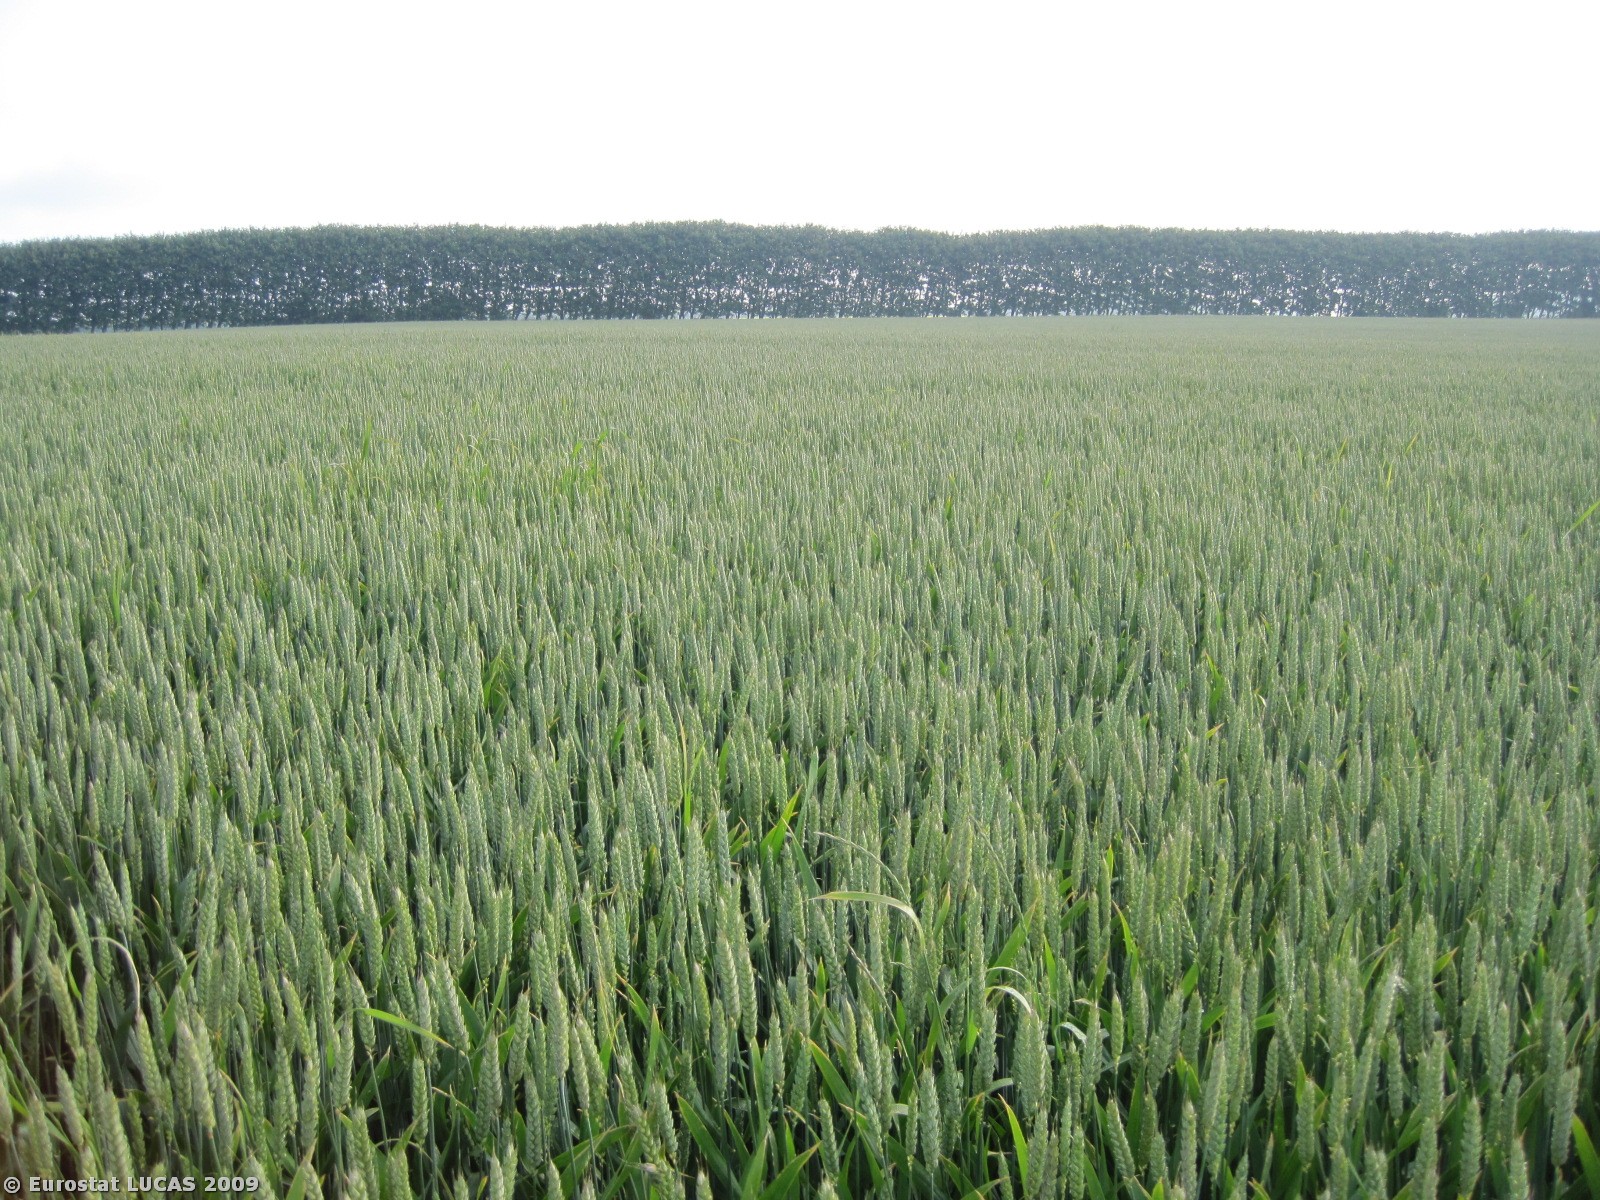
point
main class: Cropland
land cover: Common wheat
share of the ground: > 75 %
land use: Agriculture (excluding fallow land and kitchen gardens)
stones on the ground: 10 - 25 %
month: June
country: DK
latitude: 56.7589
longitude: 8.9709
